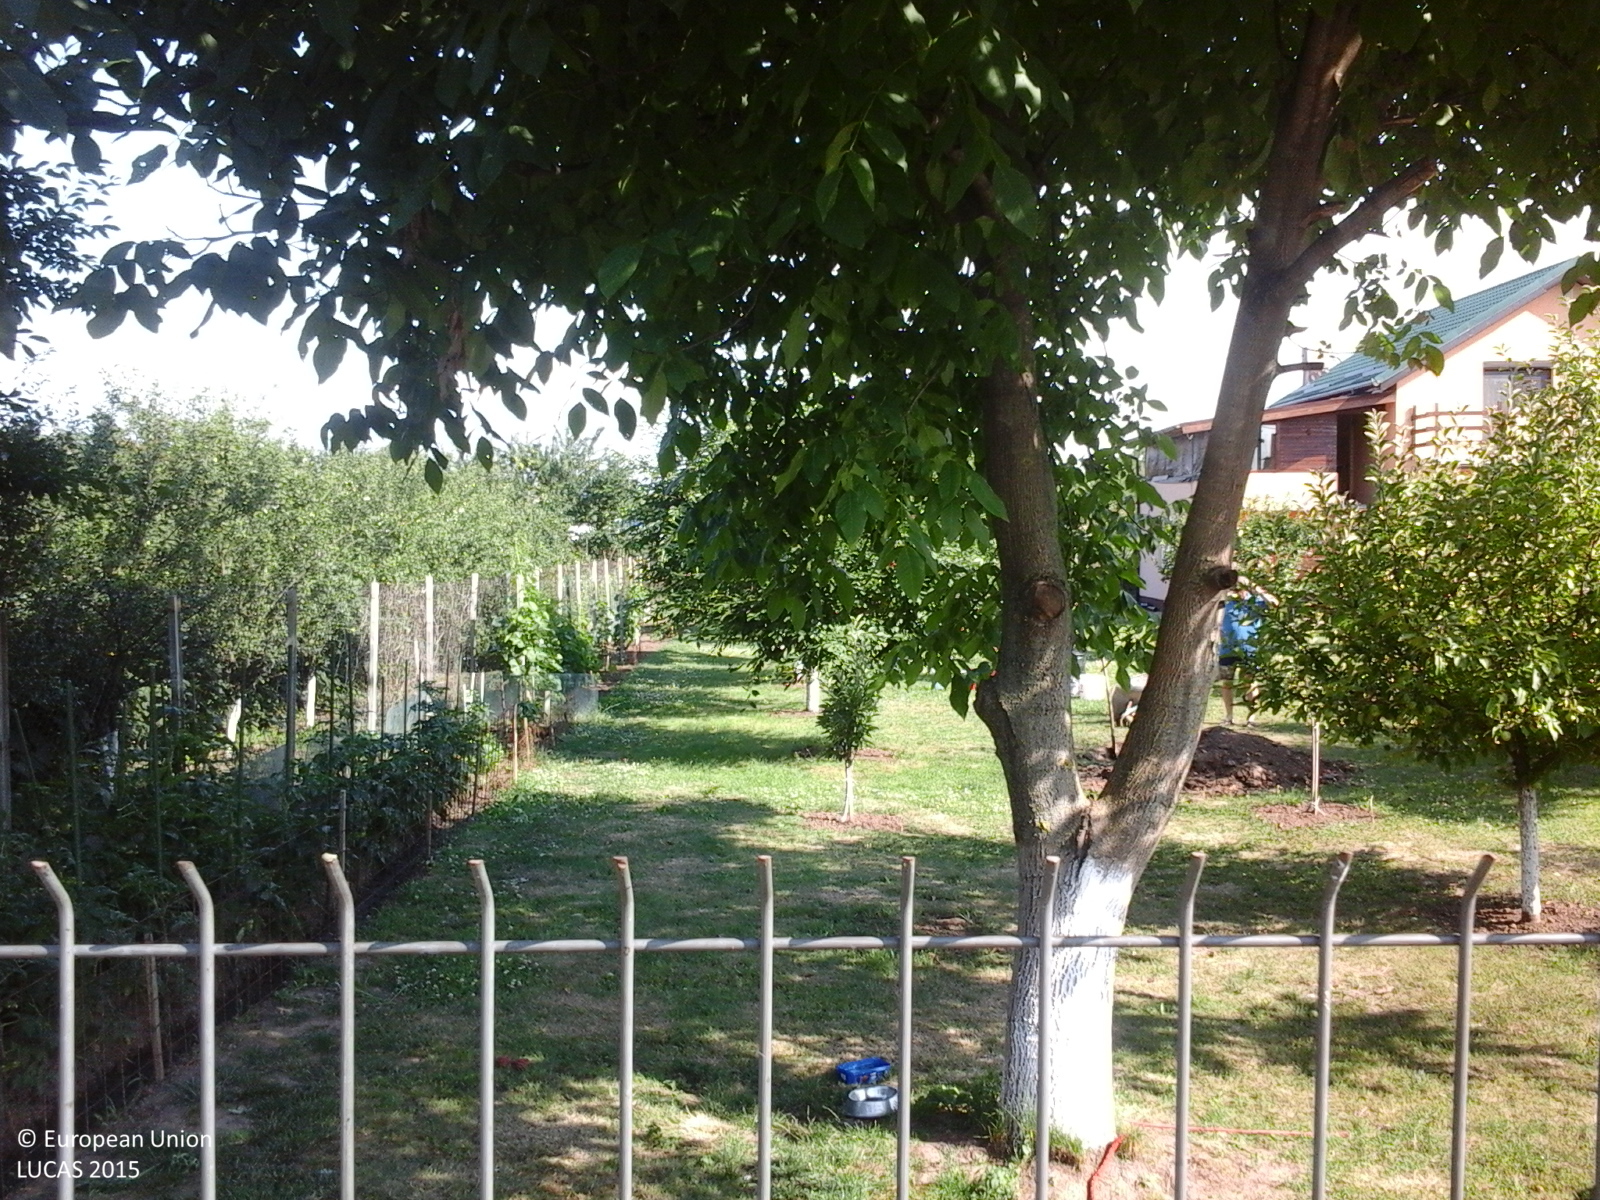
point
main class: Cropland
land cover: Apple fruit
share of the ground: 50 - 75 %
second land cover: Grassland without tree/shrub cover
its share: > 75 %
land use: Agriculture (excluding fallow land and kitchen gardens)
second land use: Residential
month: June
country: RO
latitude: 44.6061
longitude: 26.2251
